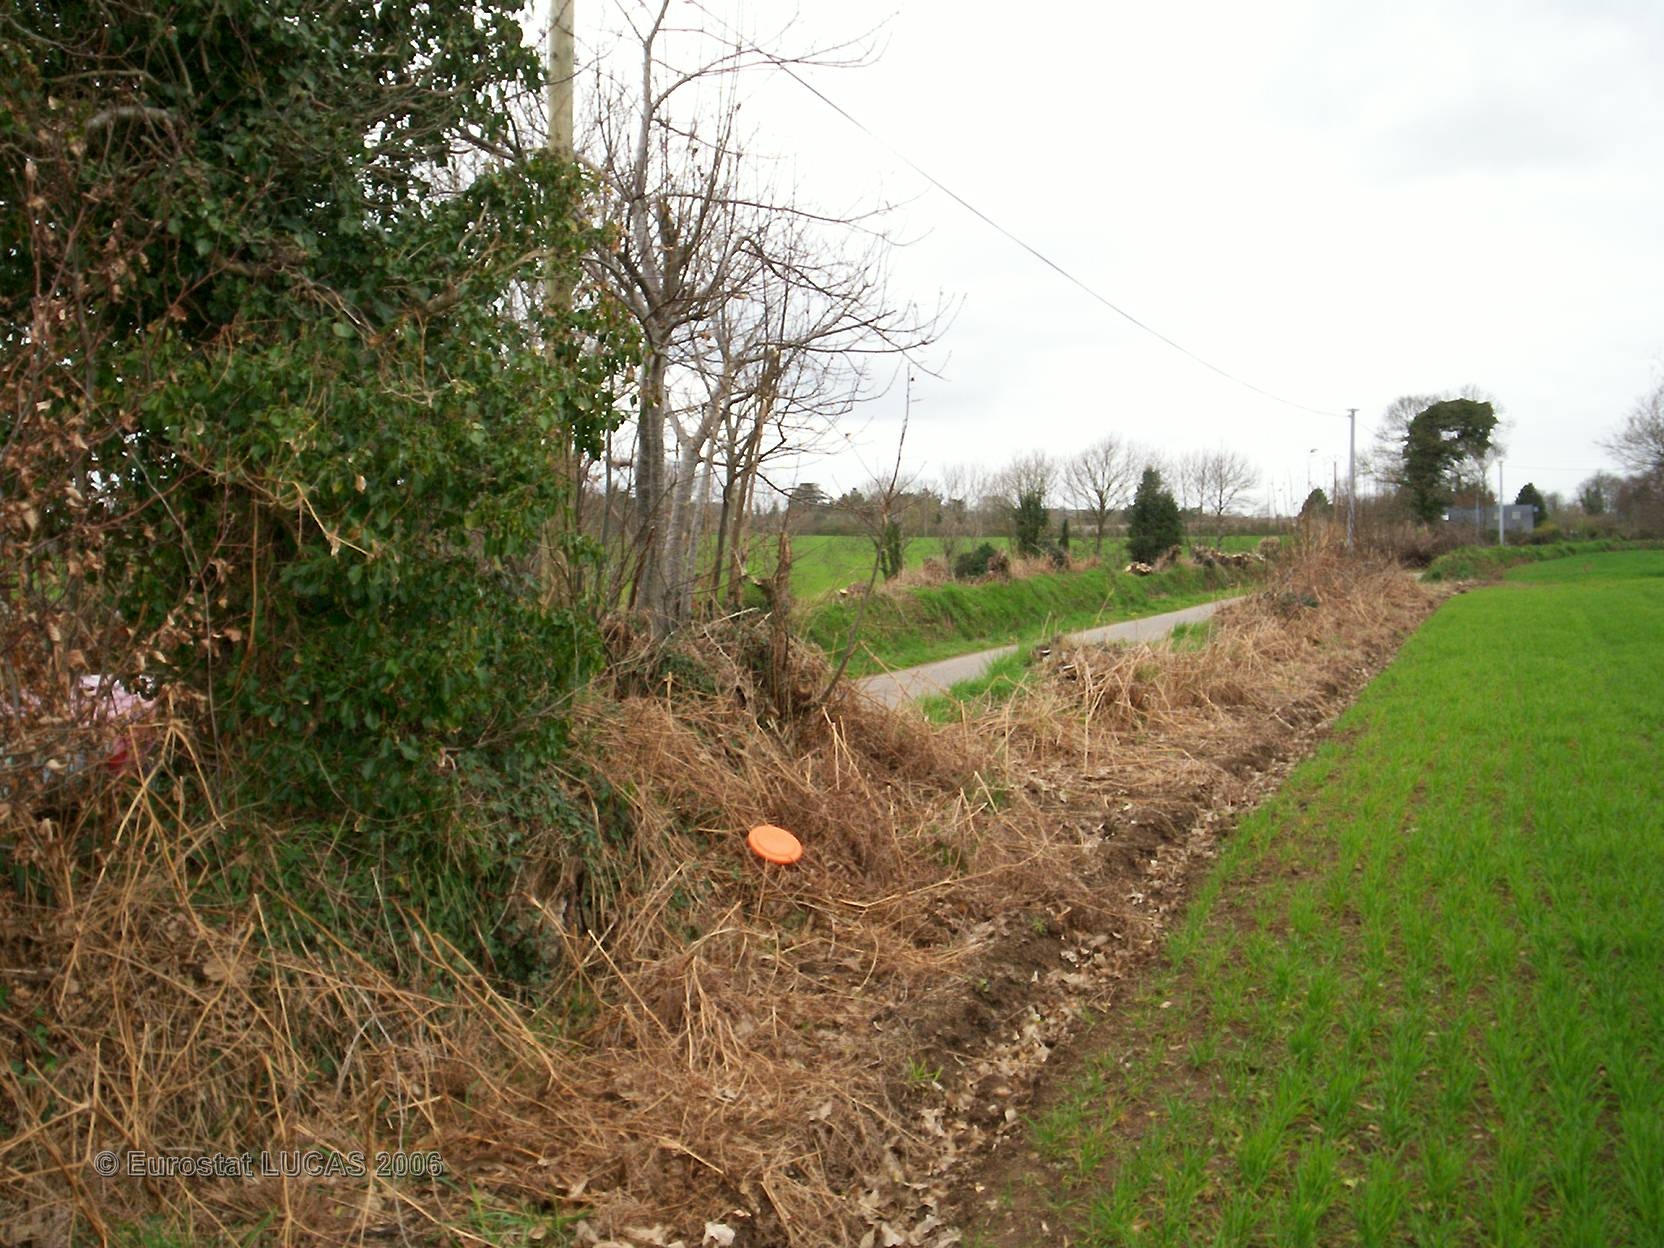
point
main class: Cropland
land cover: Common wheat
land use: Agriculture (excluding fallow land and kitchen gardens)
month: April
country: FR
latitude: 47.9818
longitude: -3.5695
